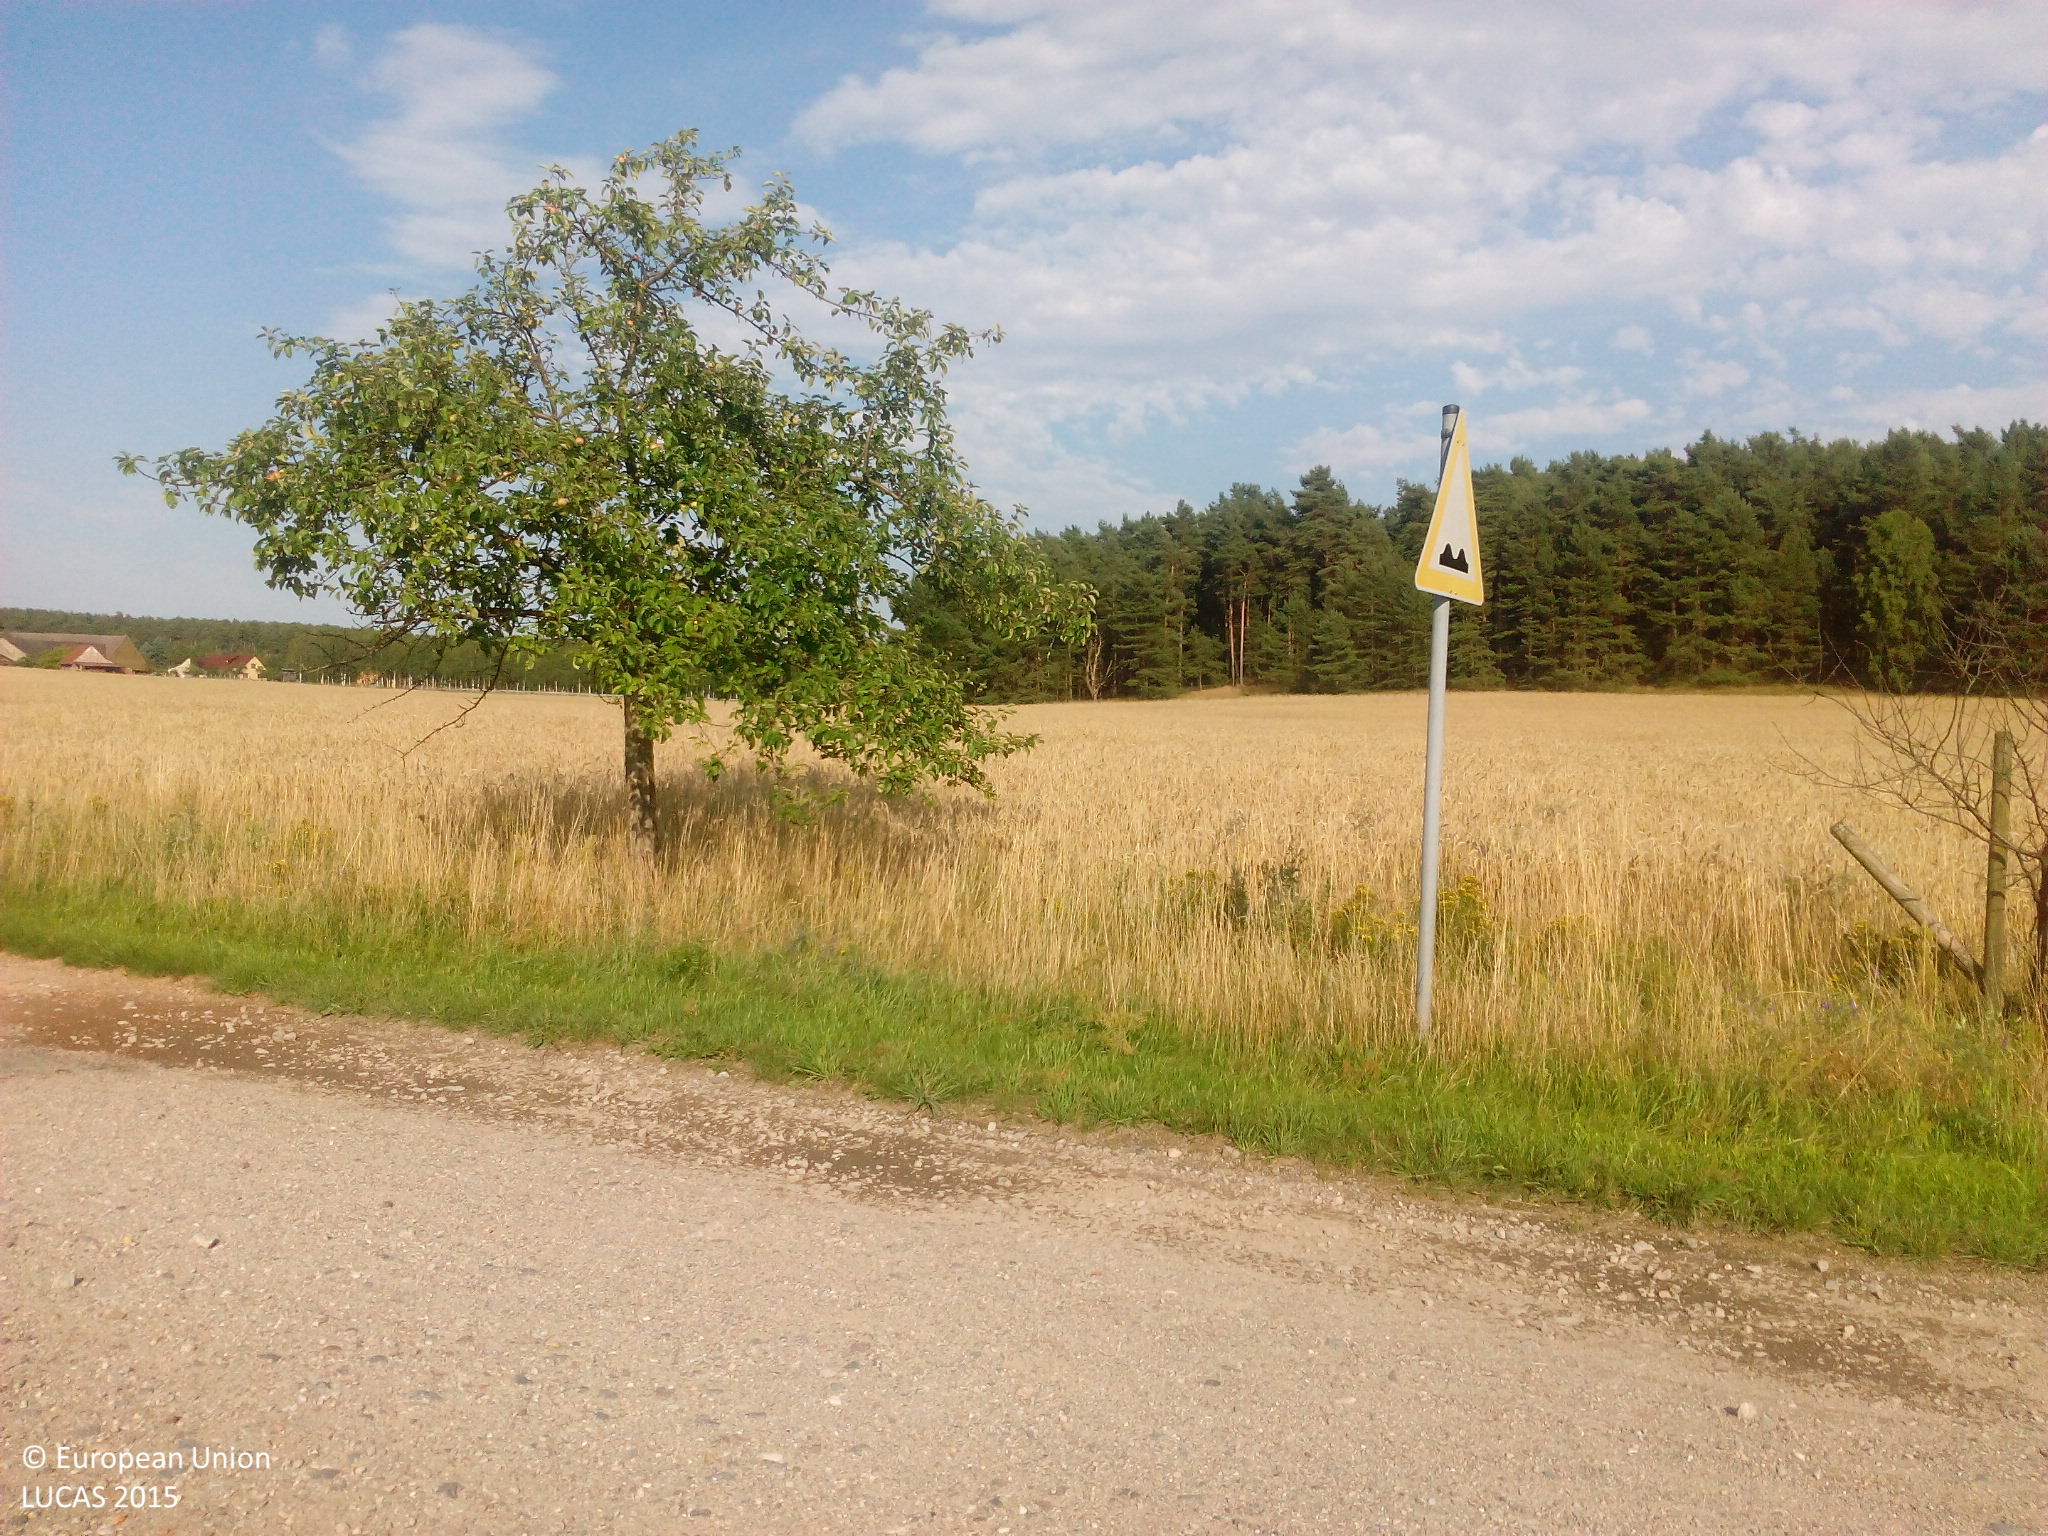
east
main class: Grassland
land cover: Grassland without tree/shrub cover
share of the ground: > 75 %
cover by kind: herbaceous plants 100 %
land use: Agriculture (excluding fallow land and kitchen gardens)
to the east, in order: Grassland without tree/shrub cover; Fences; Grass margins; Tracks; Grass margins; Lines of trees; Rye; Groves
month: July
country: DE
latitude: 51.9898
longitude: 12.5773
